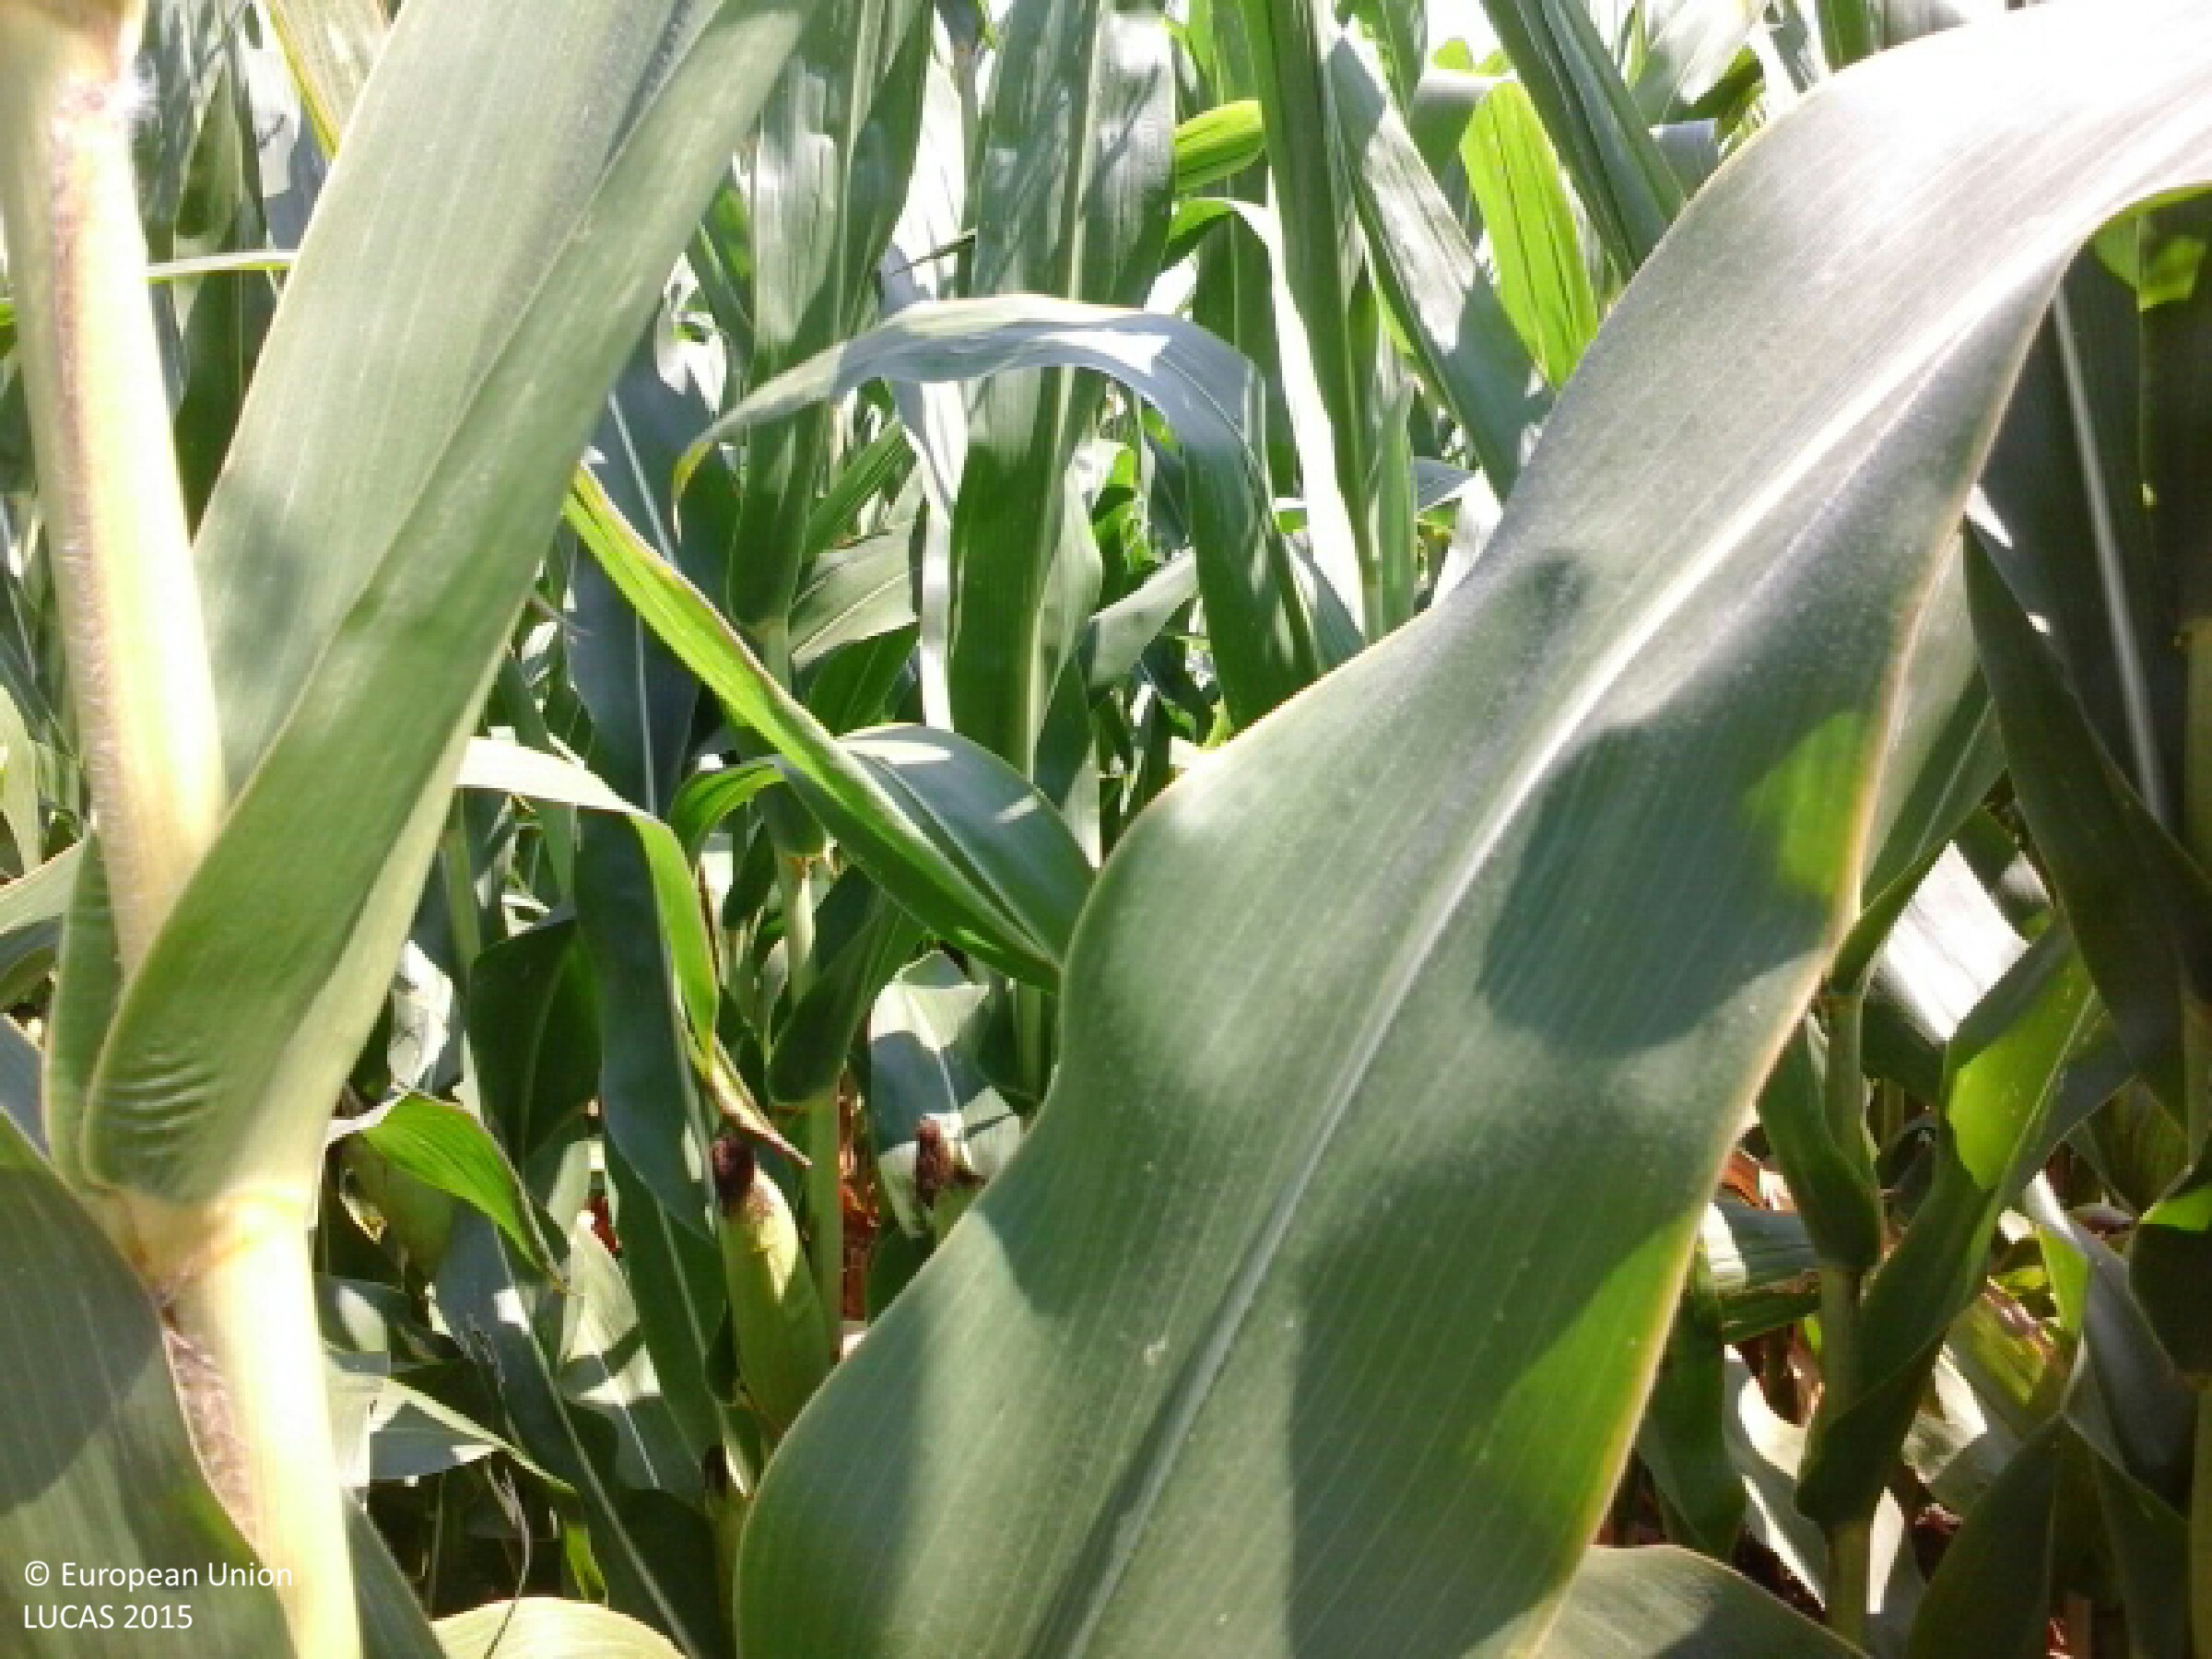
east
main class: Cropland
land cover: Maize
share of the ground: > 75 %
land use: Agriculture (excluding fallow land and kitchen gardens)
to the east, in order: Maize; Sunflower
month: August
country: HU
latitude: 47.5948
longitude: 18.1644
